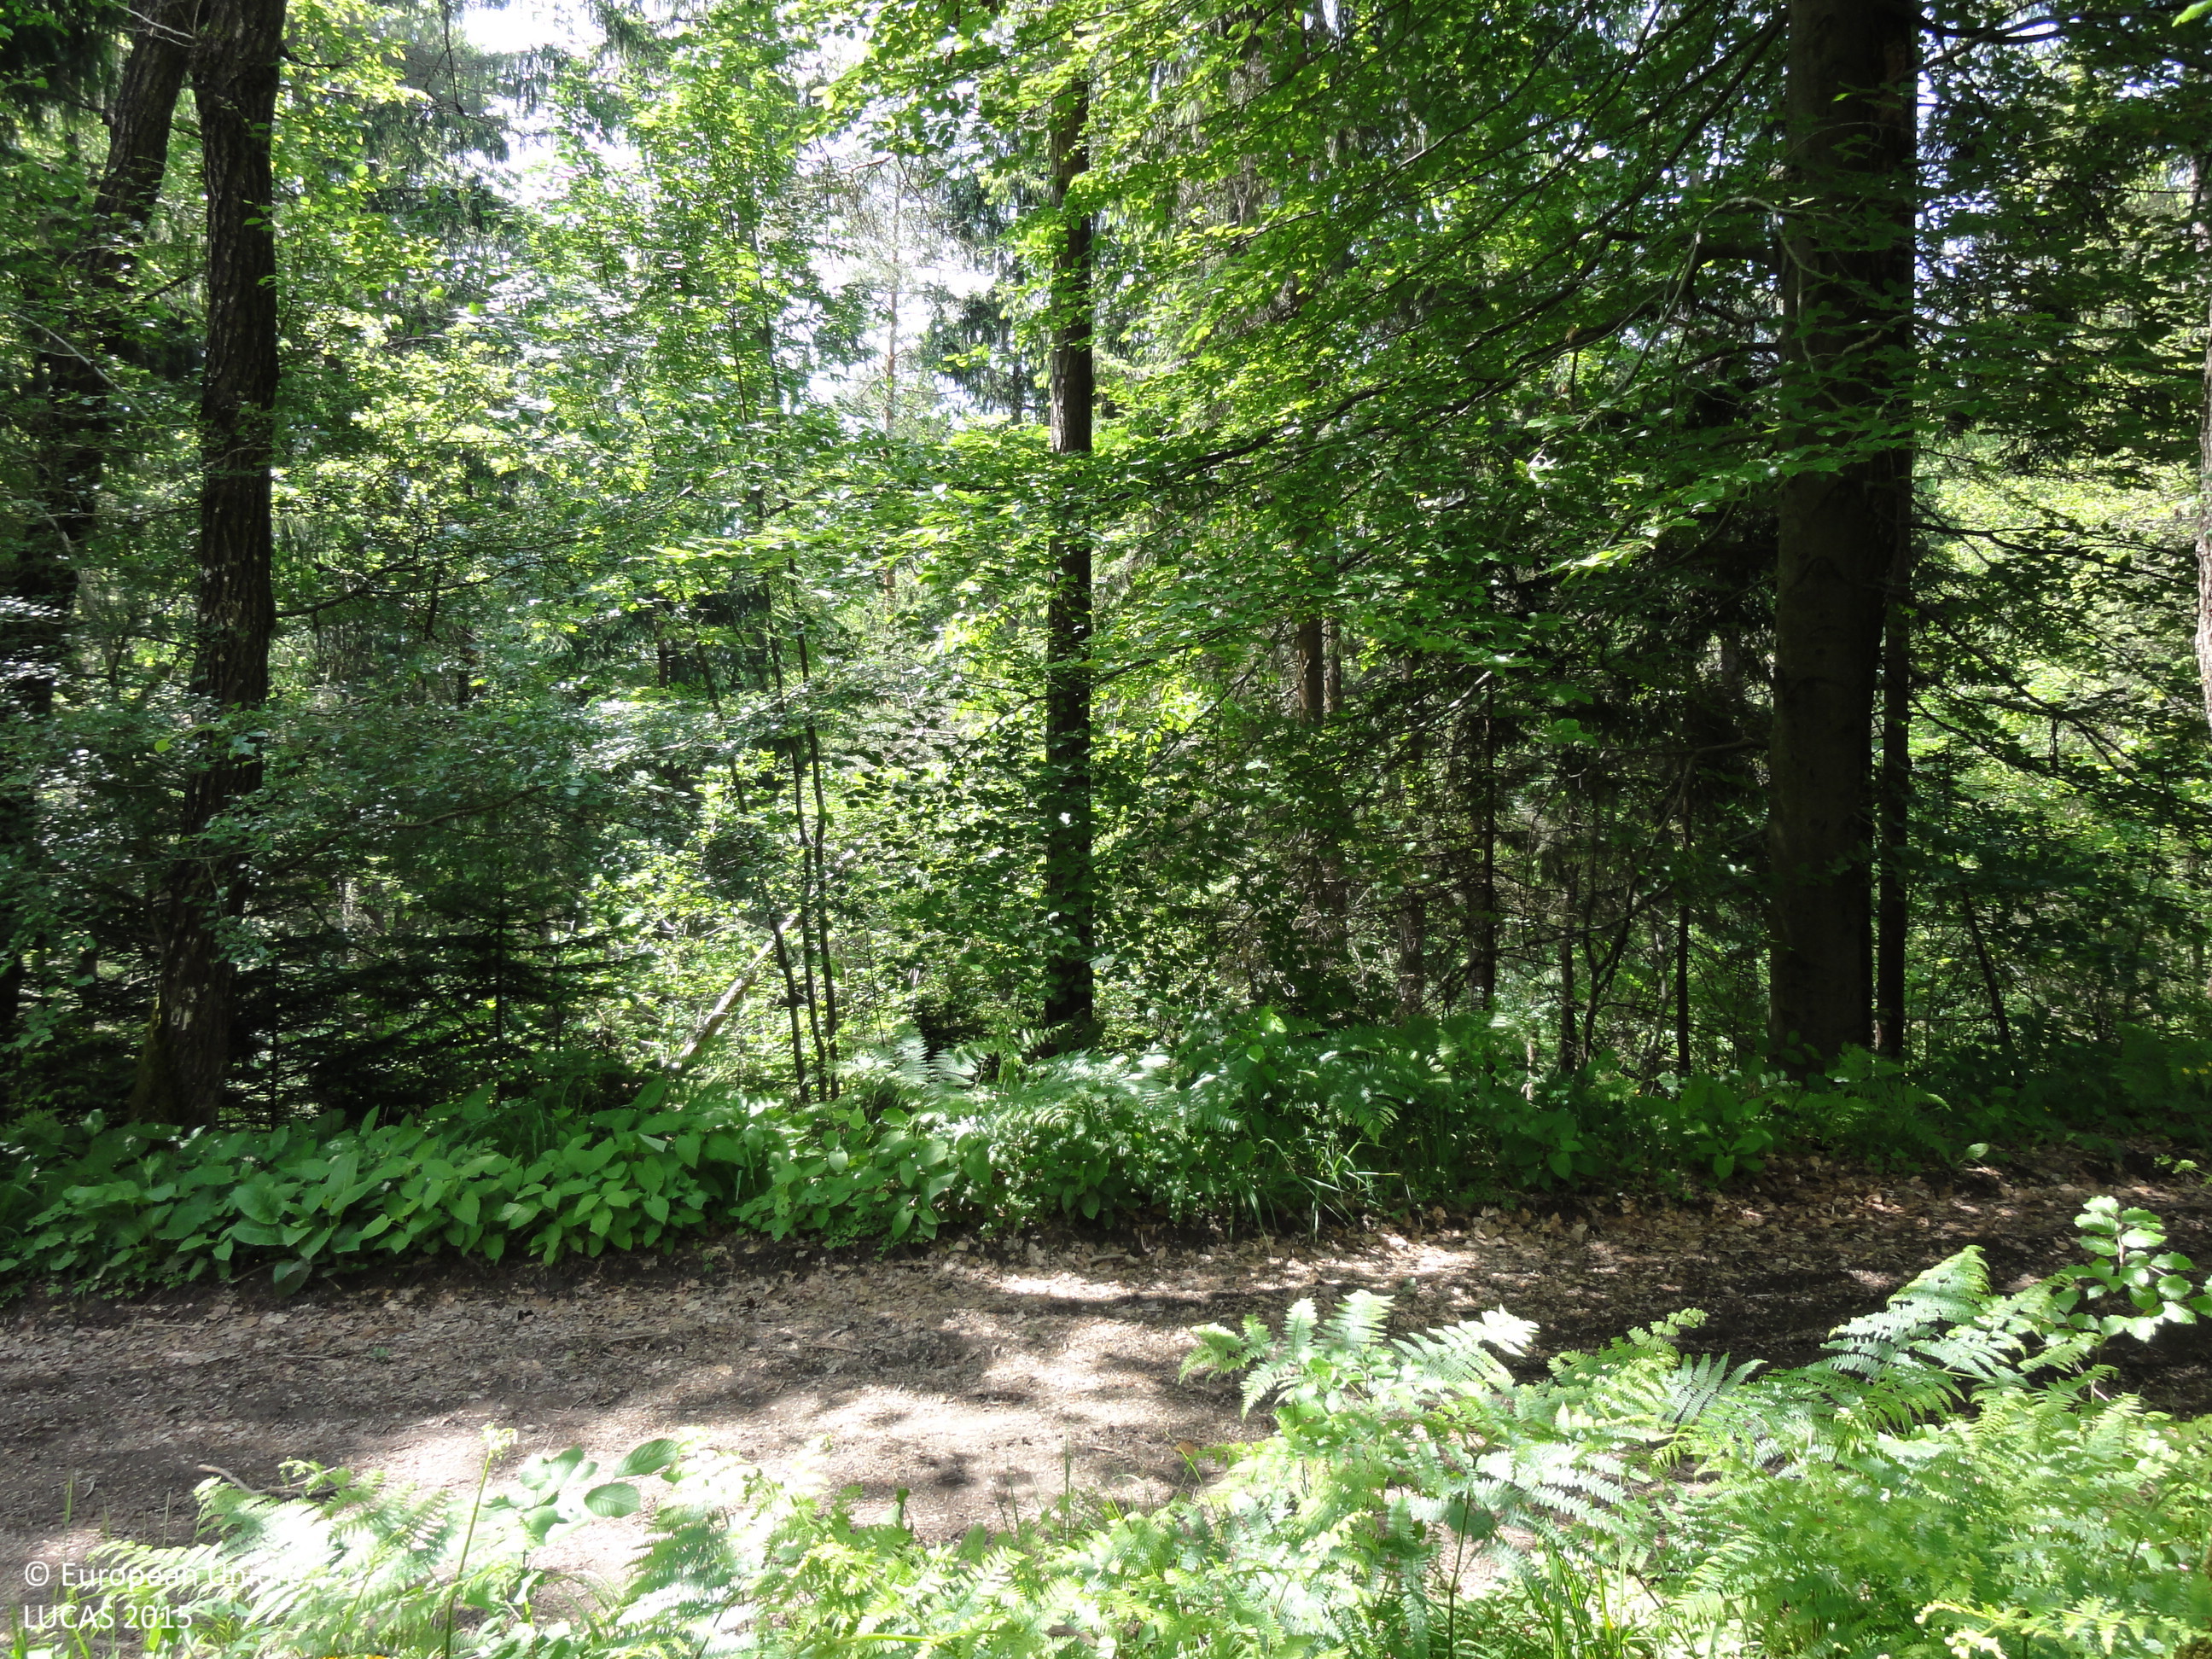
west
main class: Woodland
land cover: Pine dominated mixed woodland
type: mesophytic deciduous forest
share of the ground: > 75 %
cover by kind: coniferous forest trees 55 %, broadleaved forest trees 40 %, shrubs 5 %
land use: Forestry
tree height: > 5 m
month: May
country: SI
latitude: 46.2763
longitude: 15.2535
